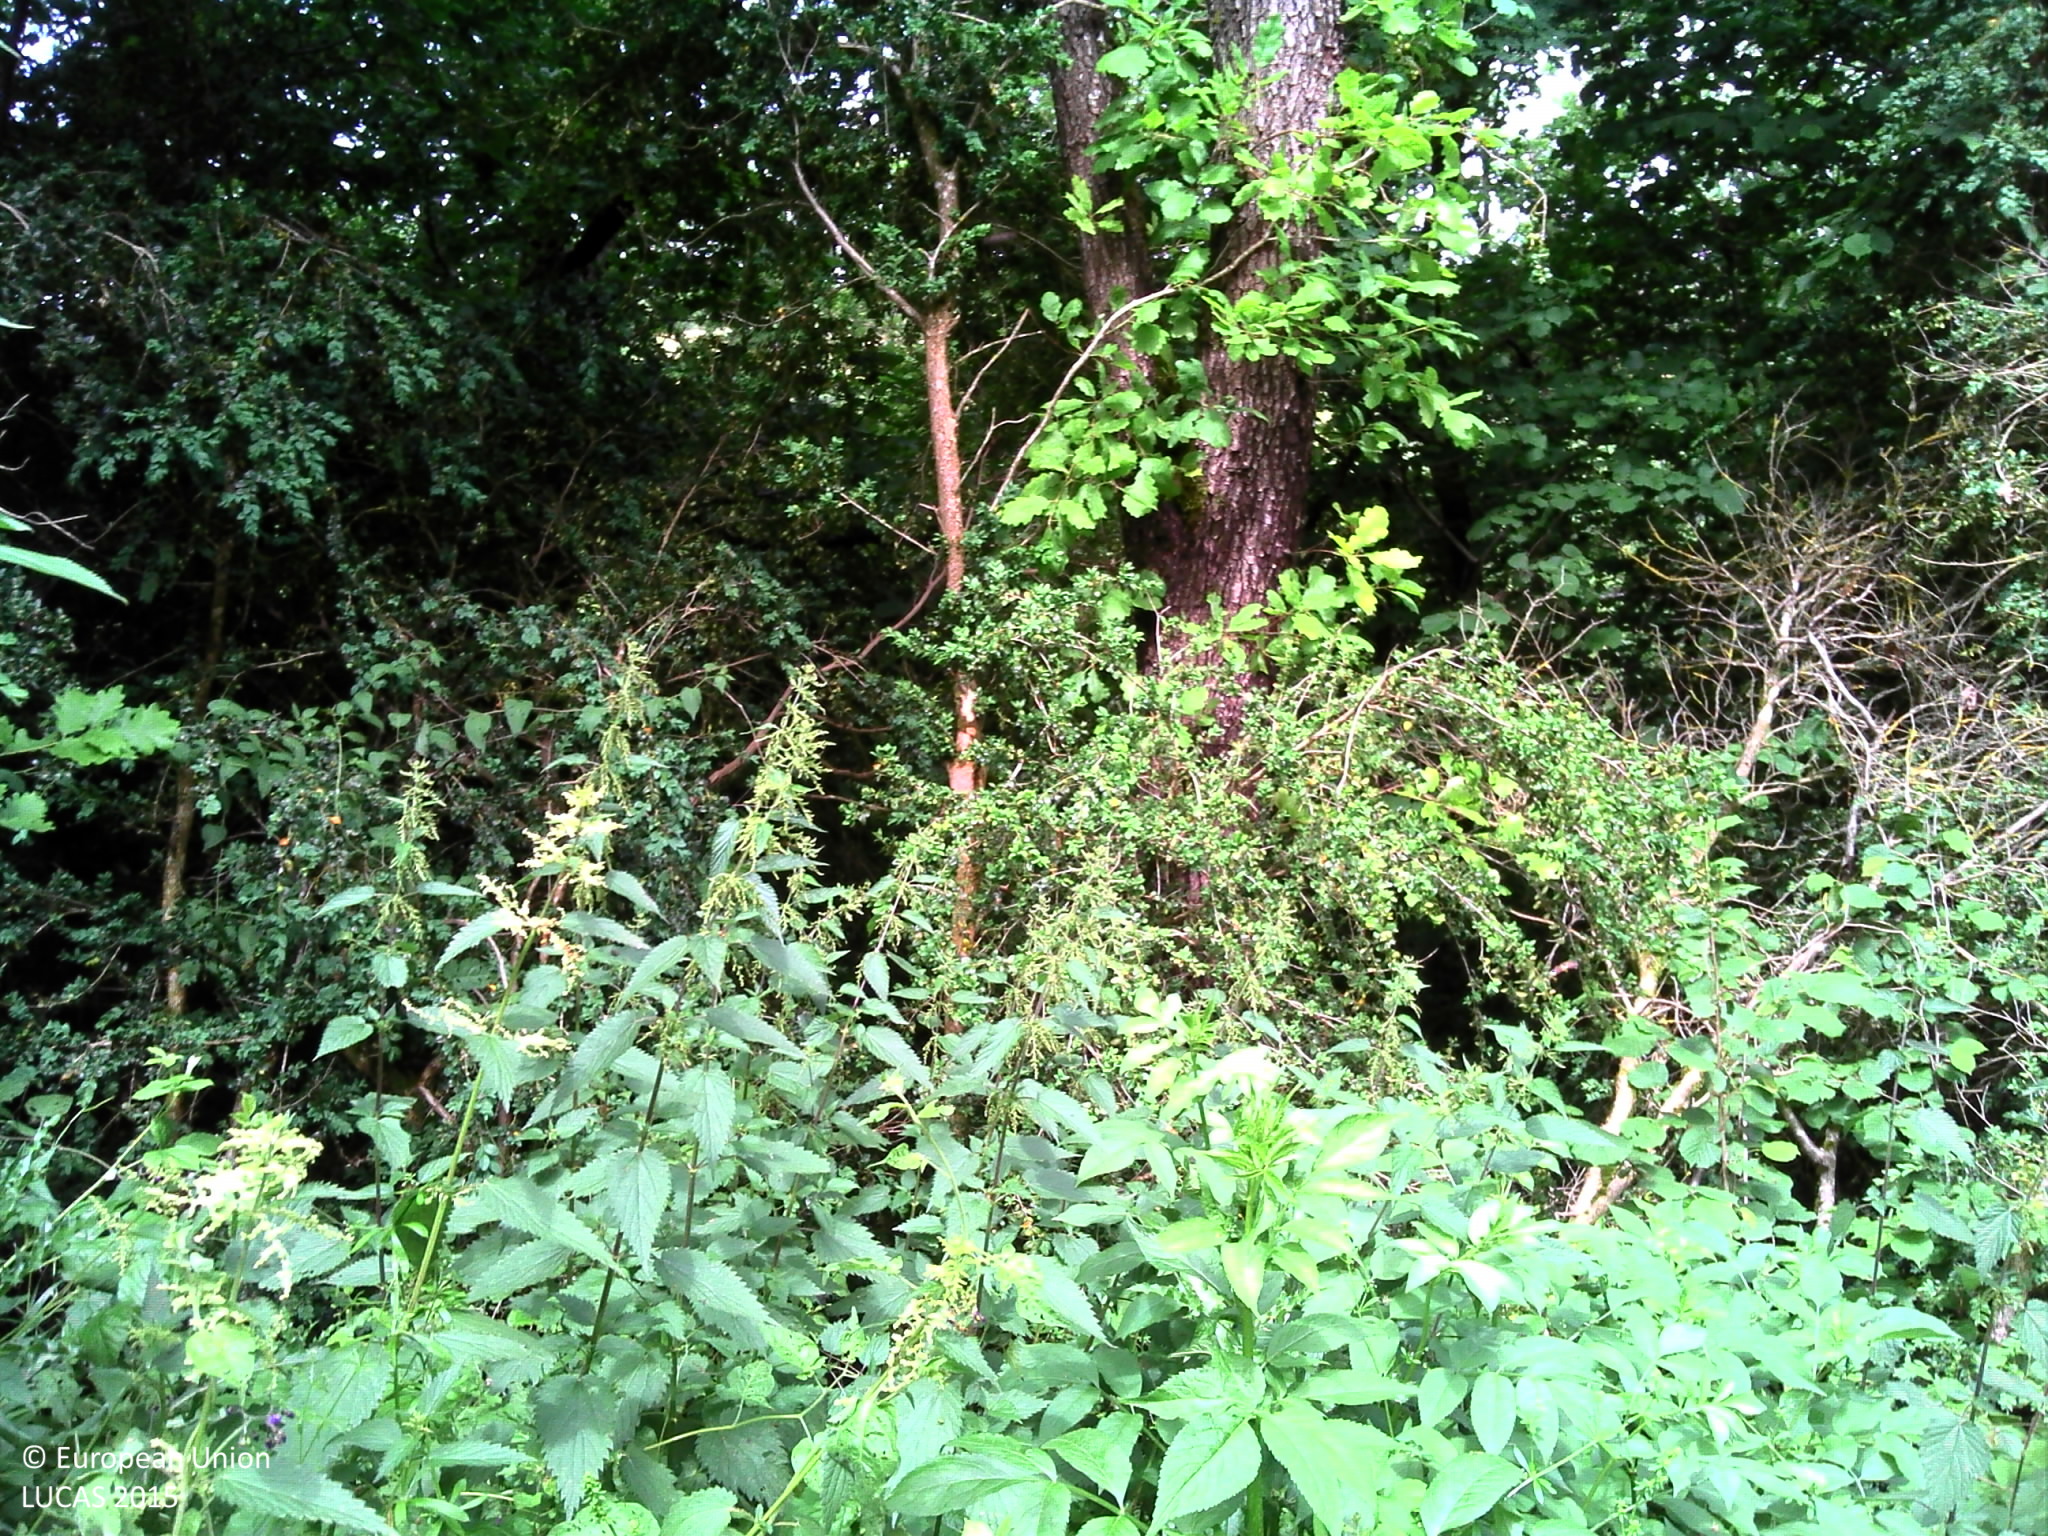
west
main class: Woodland
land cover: Broadleaved woodland
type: acidophilous oak and oak-birch forest
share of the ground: > 75 %
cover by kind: broadleaved forest trees 90 %, lichens and mosses 10 %
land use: Semi-natural and natural areas not in use
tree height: > 5 m
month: June
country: FR
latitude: 44.2820
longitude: 3.0758
